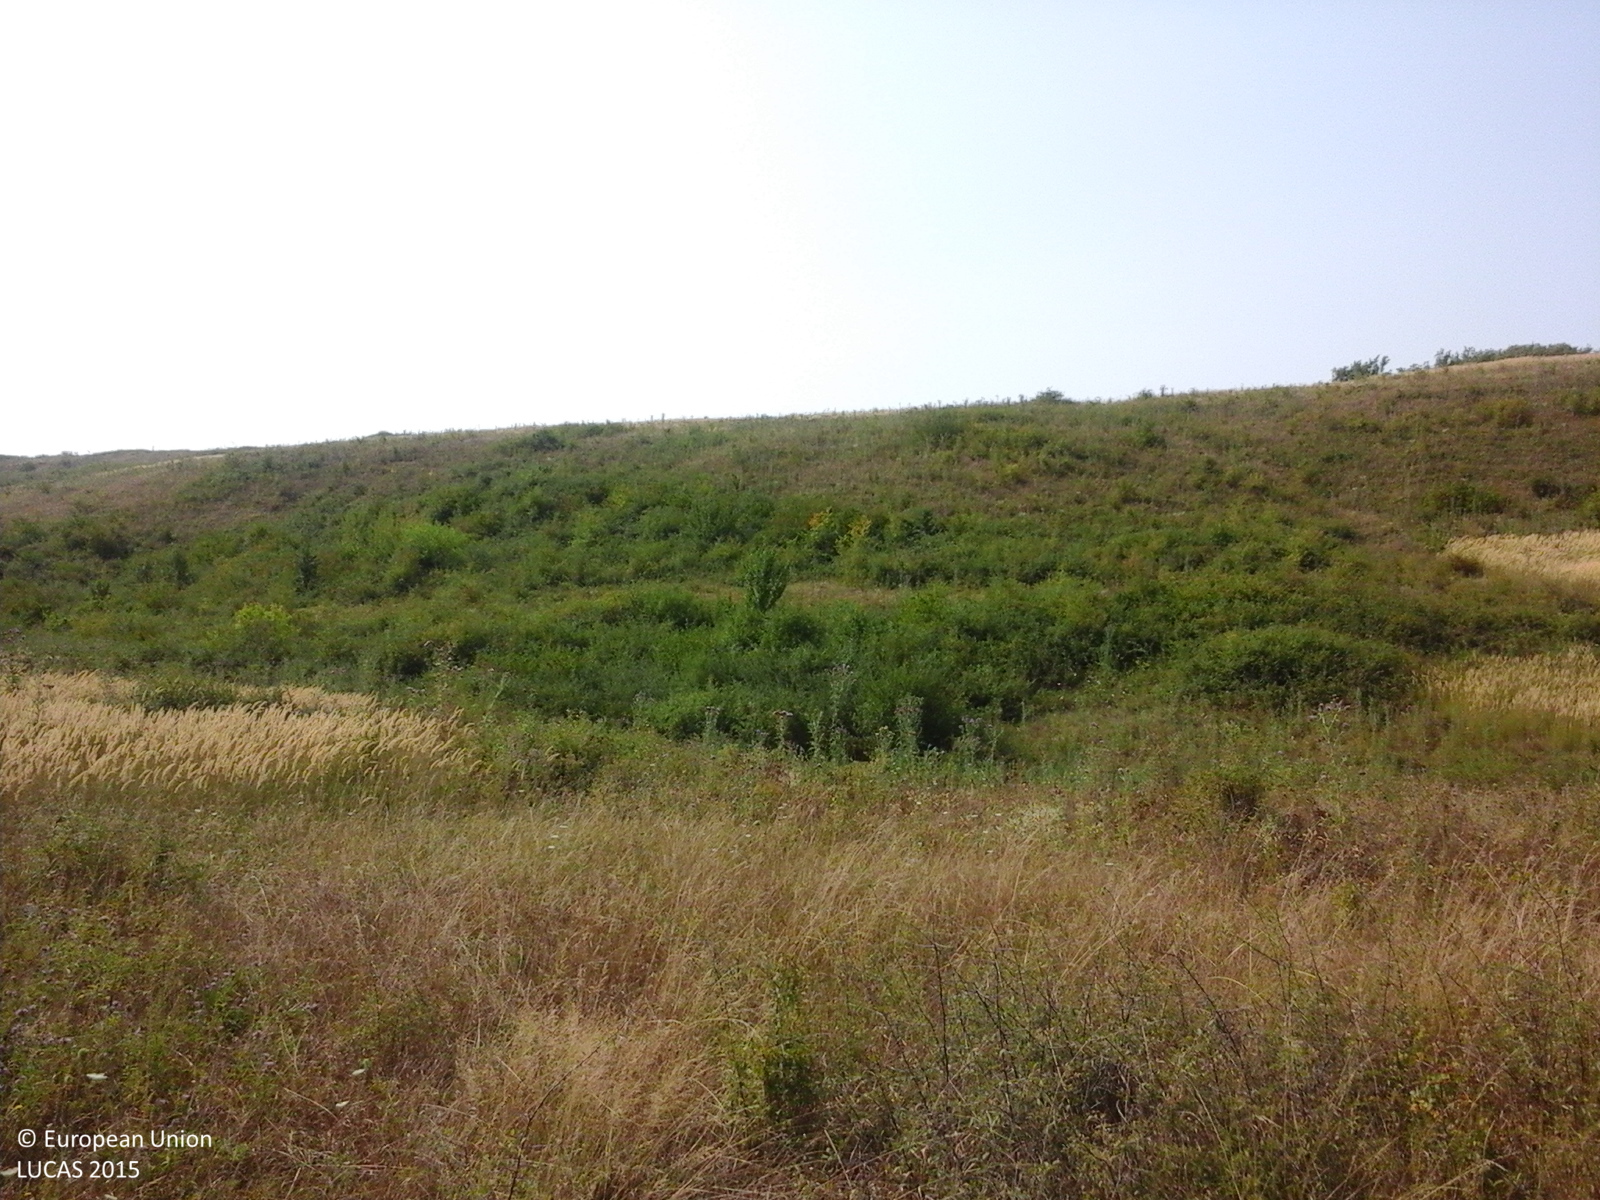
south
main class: Grassland
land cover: Spontaneously vegetated surfaces
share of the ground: > 75 %
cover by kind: herbaceous plants 100 %
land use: Fallow land
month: August
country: RO
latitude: 44.4824
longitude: 23.3916
